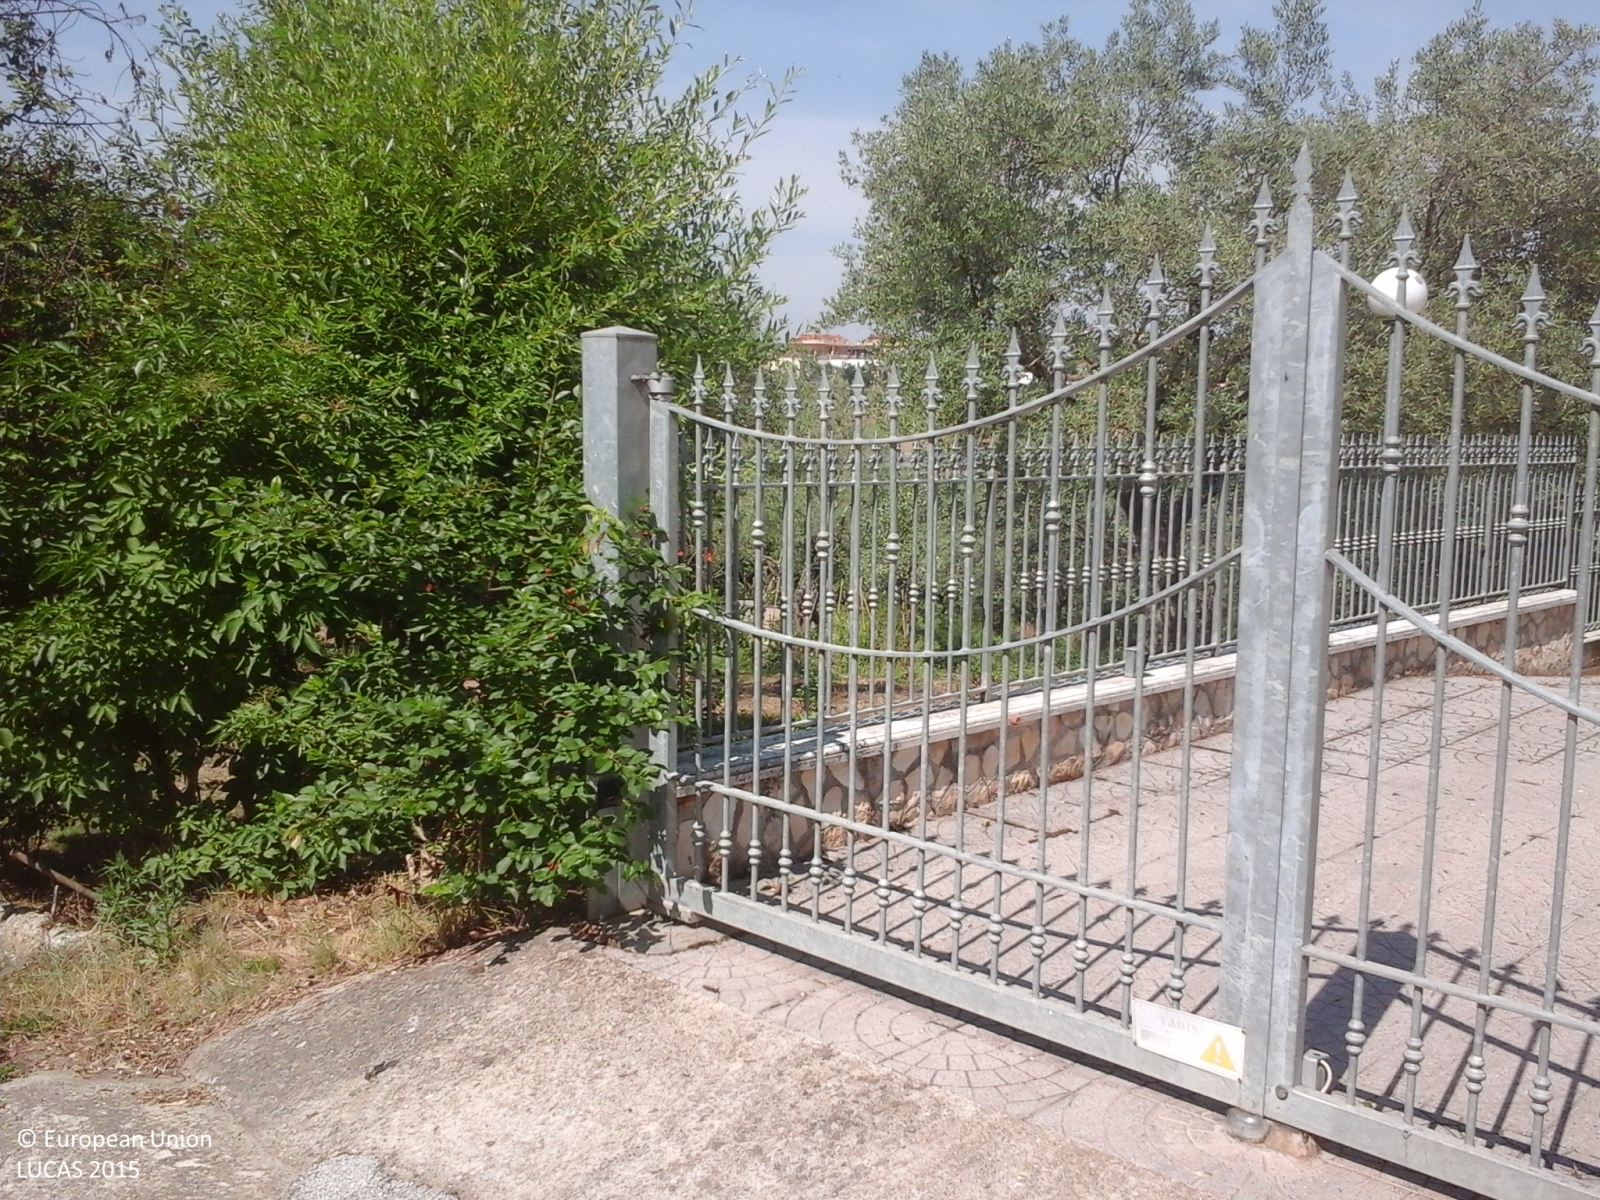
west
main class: Cropland
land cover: Olive groves
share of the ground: 50 - 75 %
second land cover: Spontaneously vegetated surfaces
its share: 10 - 25 %
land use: Agriculture (excluding fallow land and kitchen gardens)
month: June
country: IT
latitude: 41.1139
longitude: 15.0901
